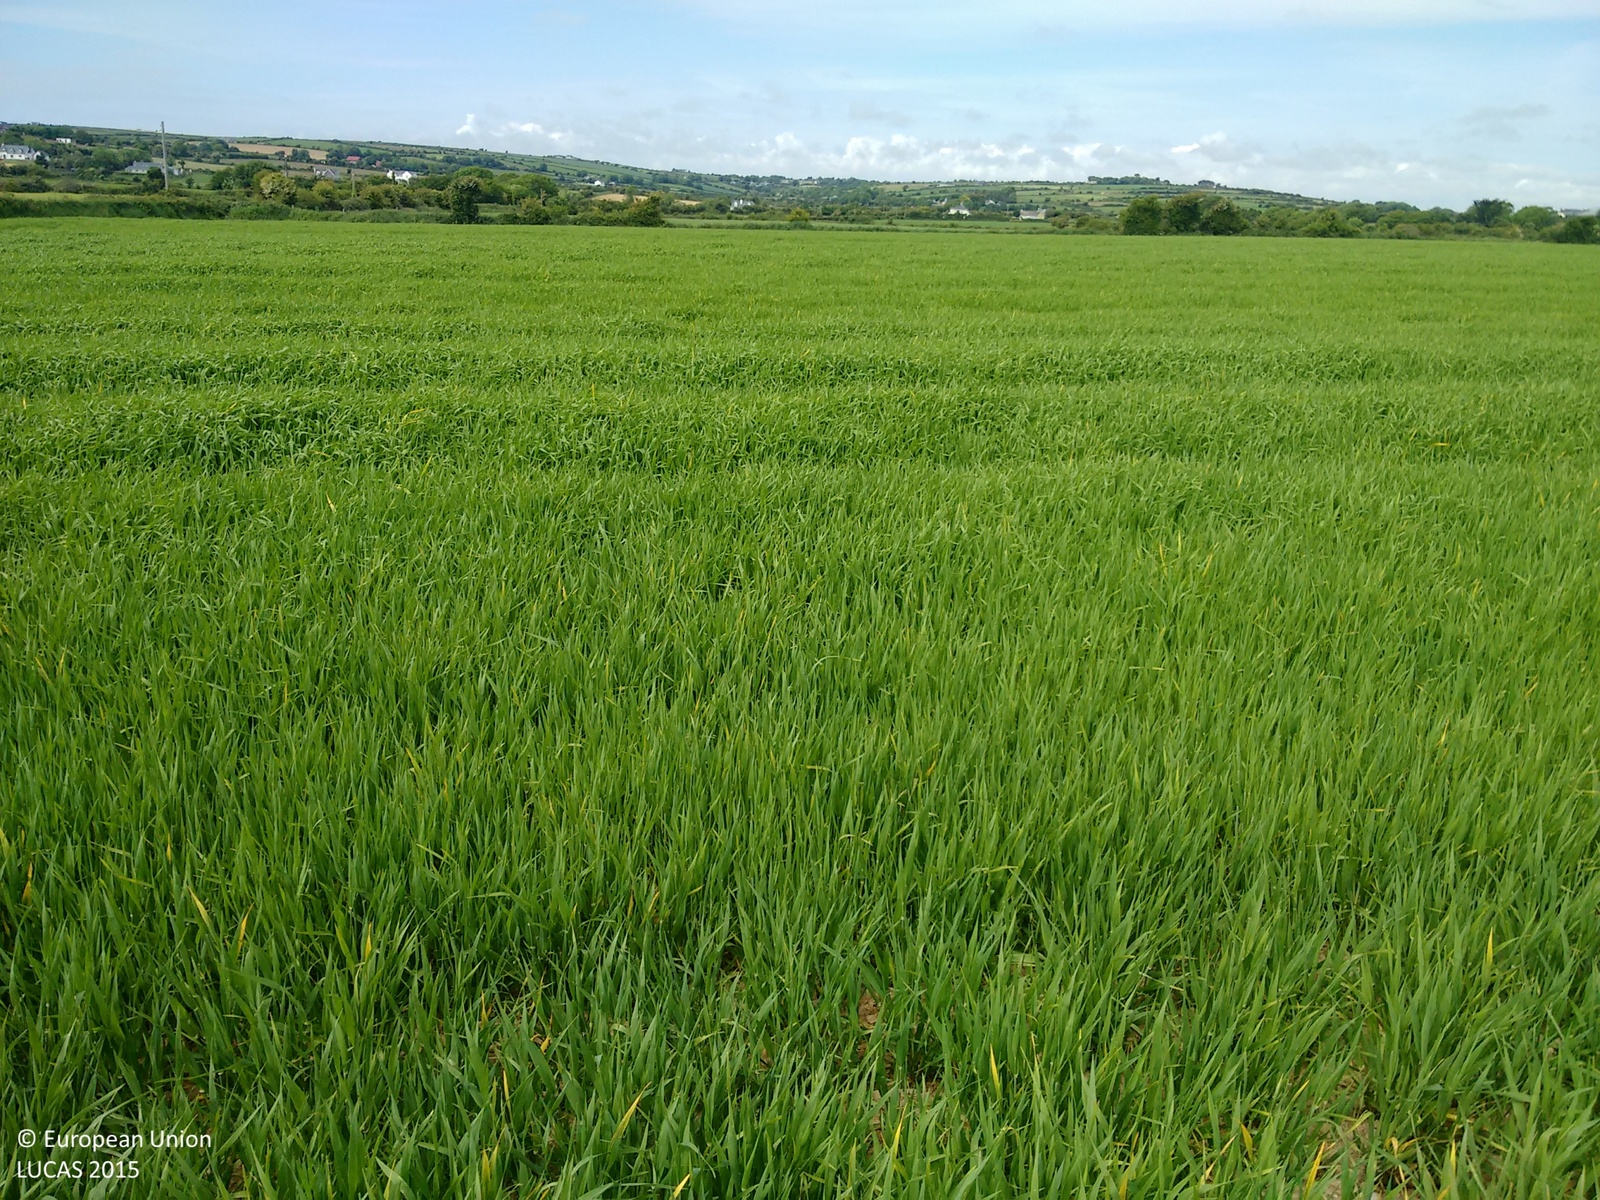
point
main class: Cropland
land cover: Barley
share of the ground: > 75 %
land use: Agriculture (excluding fallow land and kitchen gardens)
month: June
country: IE
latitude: 51.8444
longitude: -8.0462
